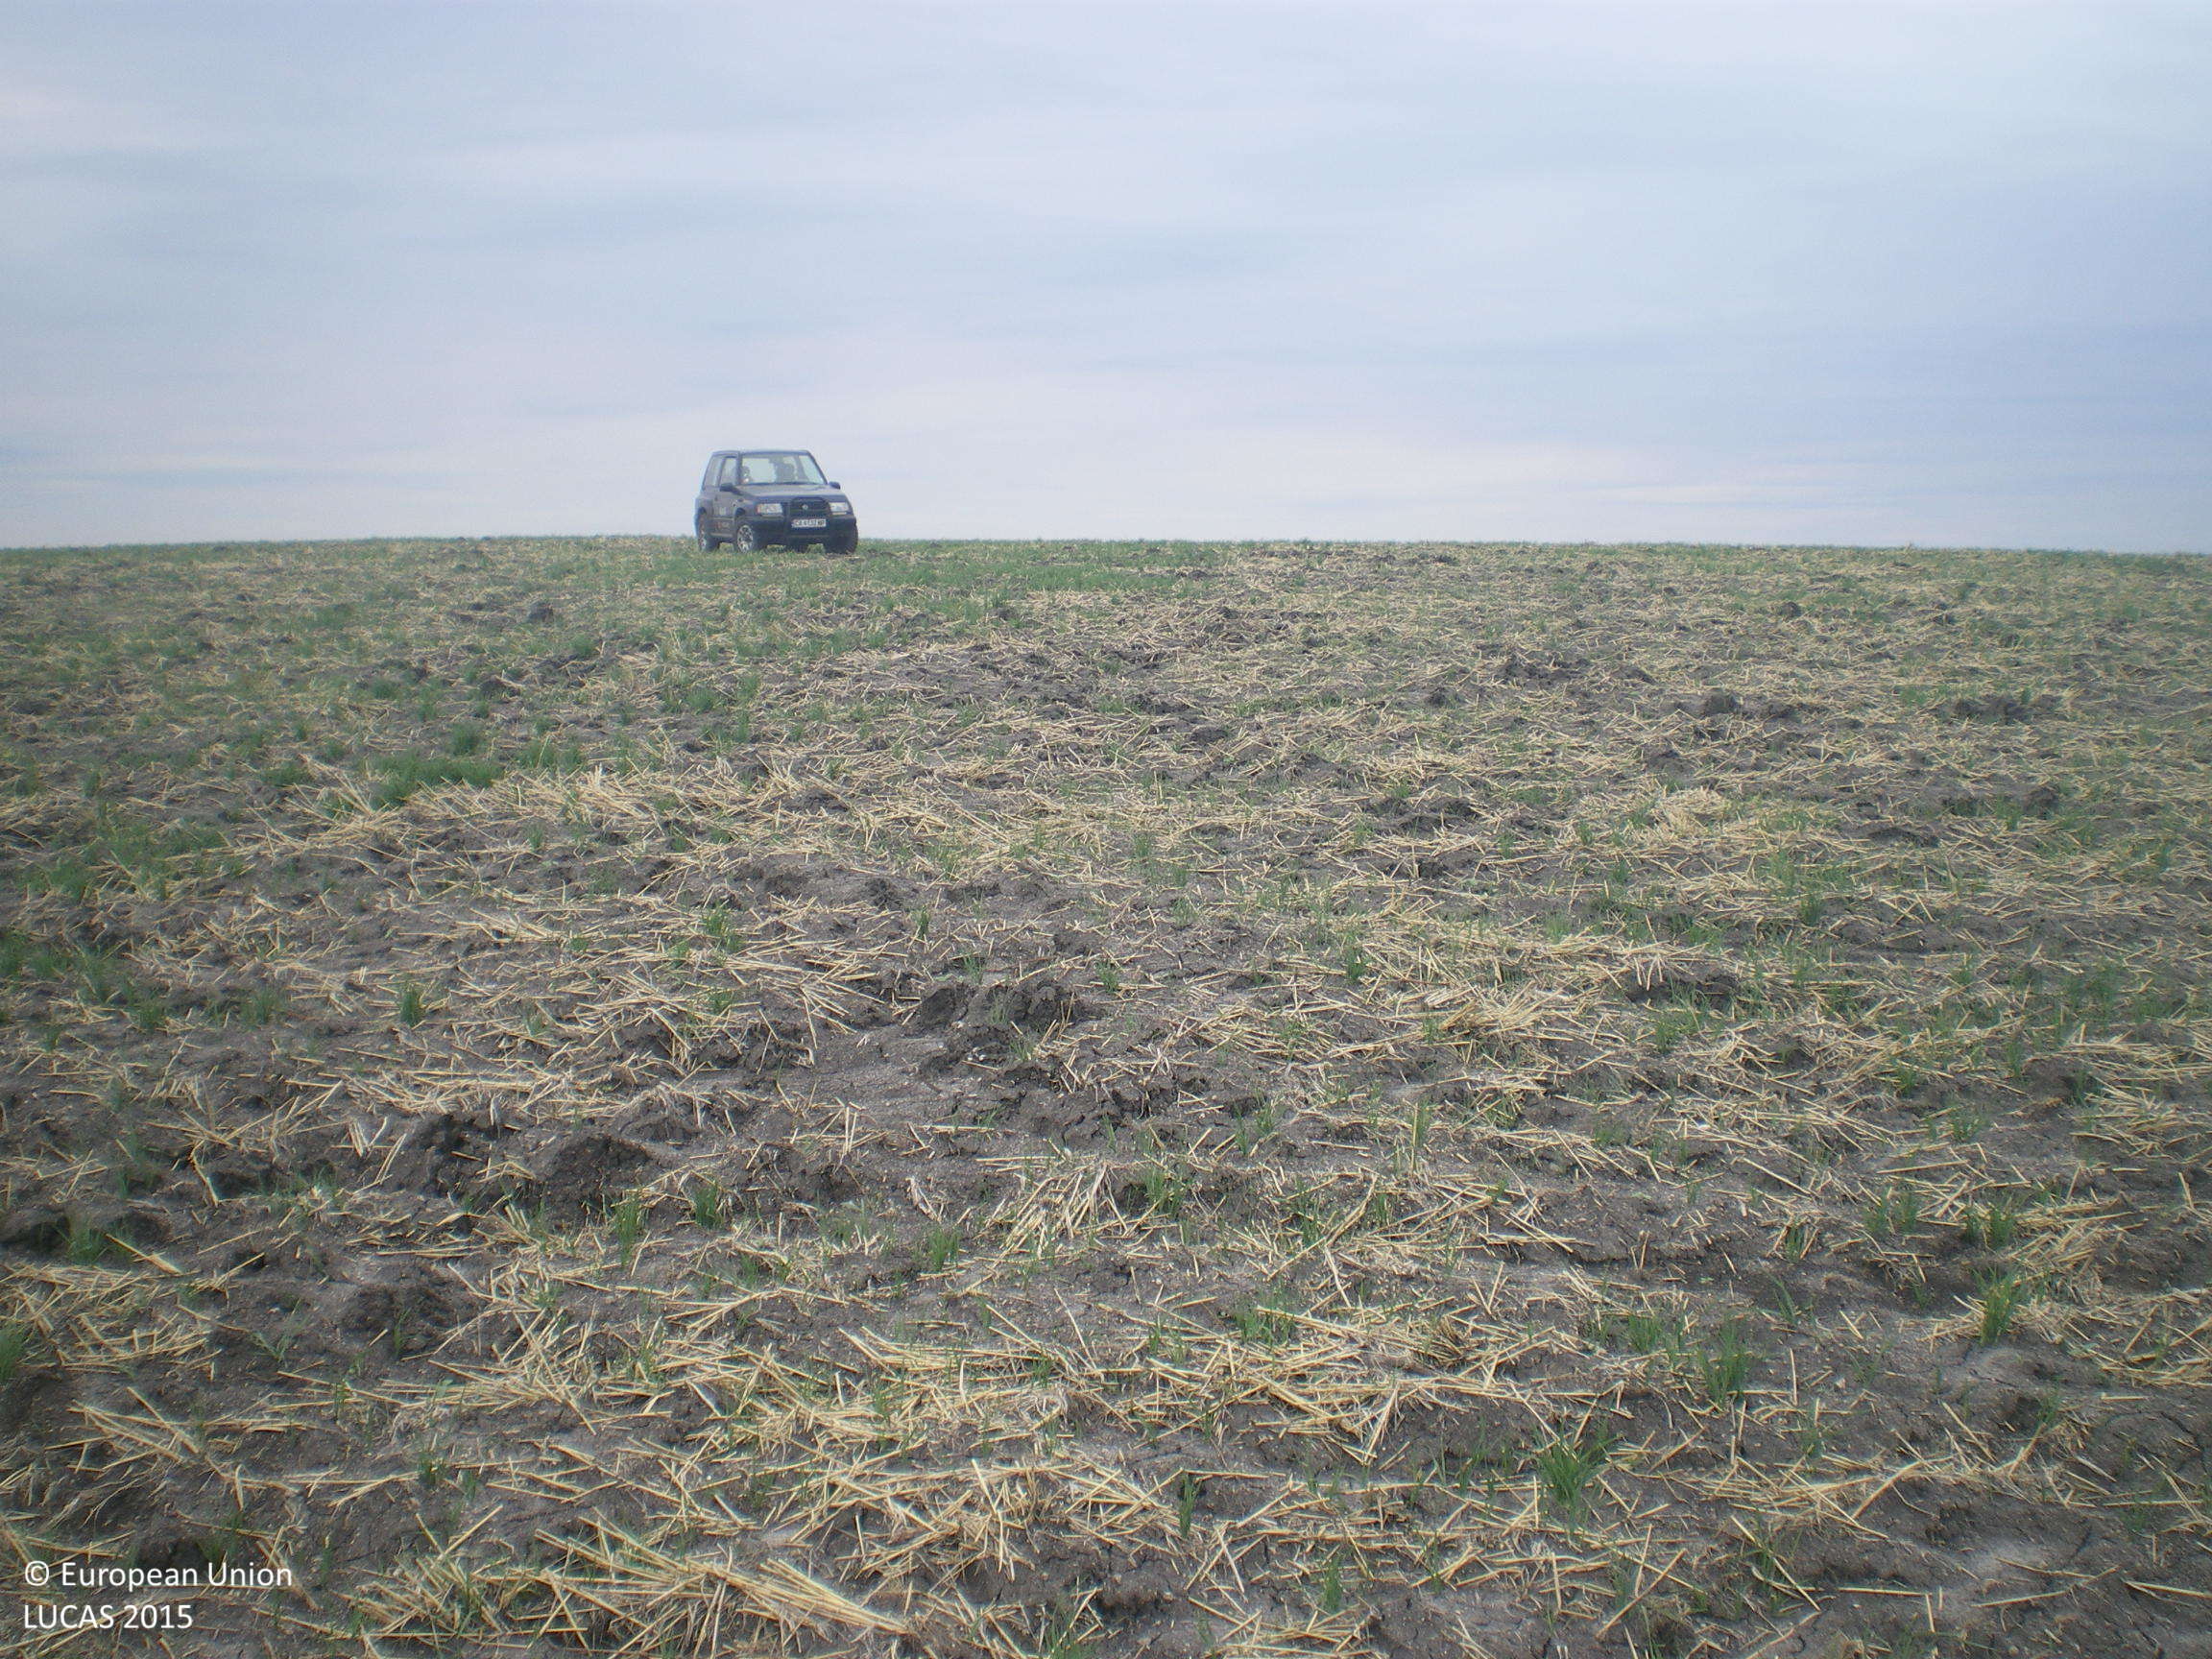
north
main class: Cropland
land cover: Common wheat
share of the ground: < 10 %
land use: Agriculture (excluding fallow land and kitchen gardens)
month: September
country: BG
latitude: 42.1965
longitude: 25.9028
